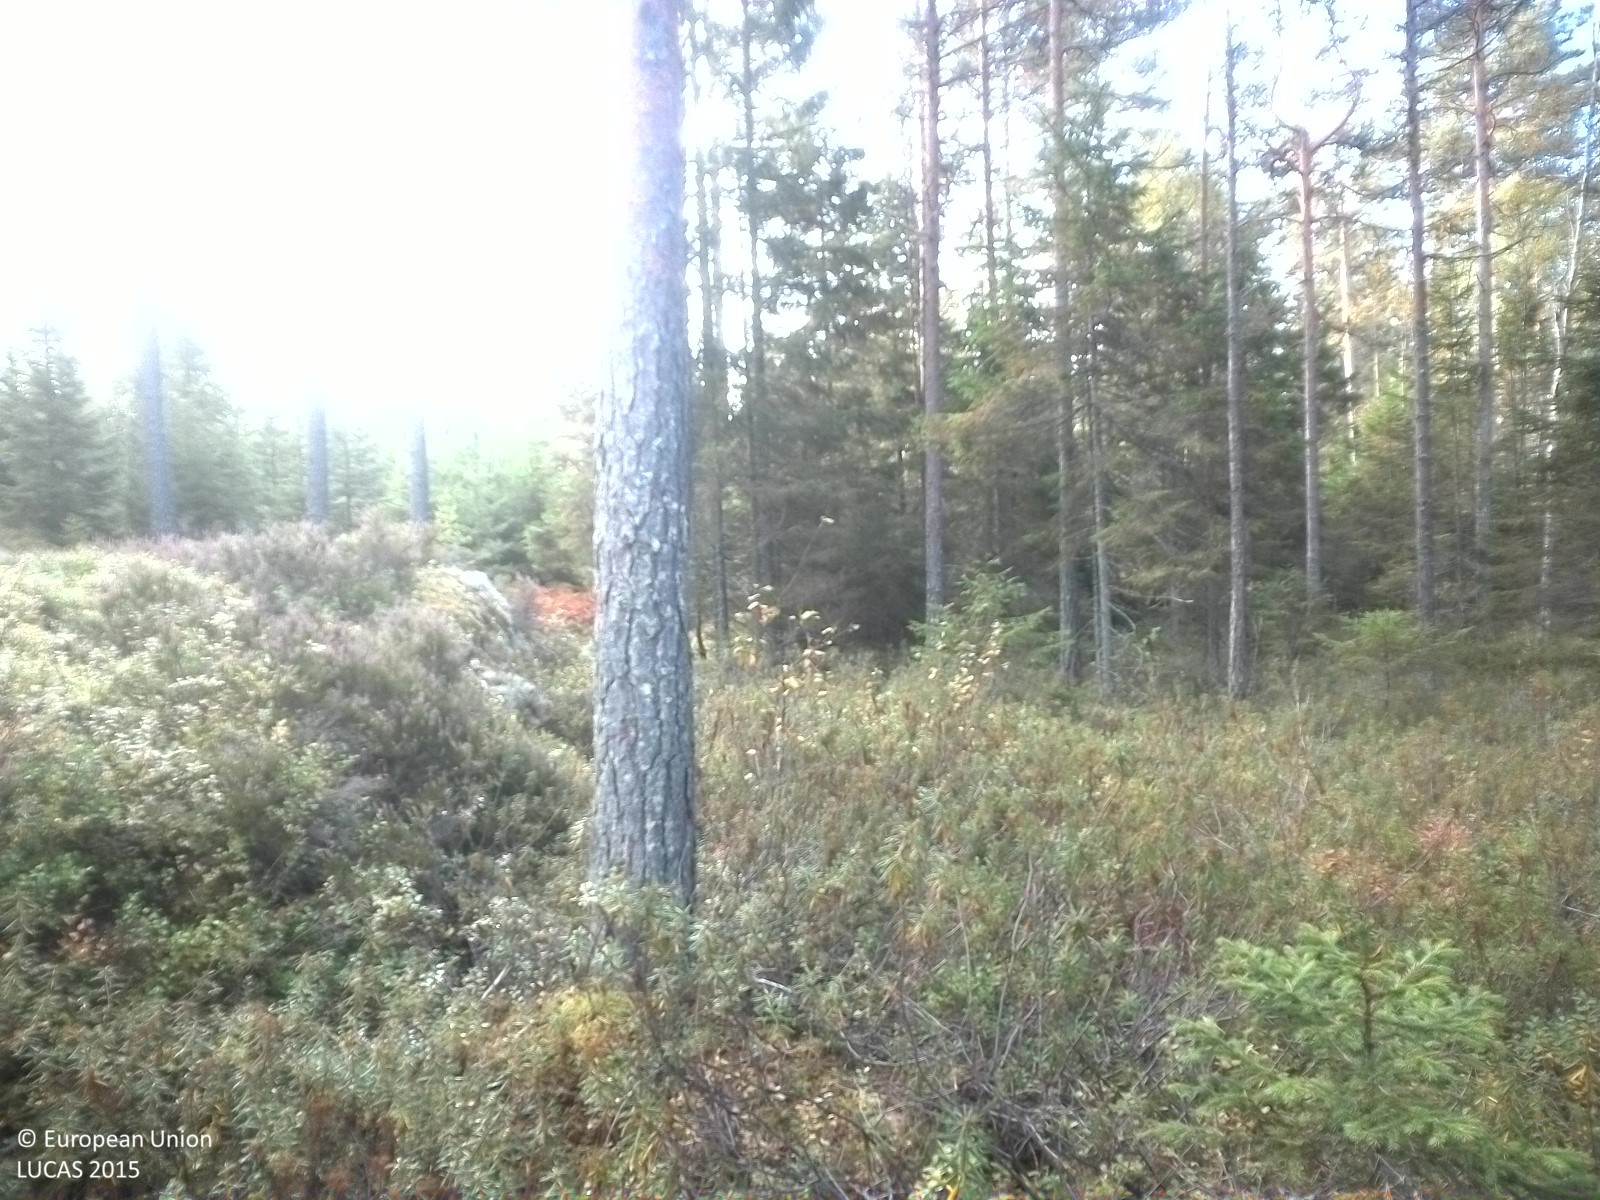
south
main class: Woodland
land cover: Pine dominated coniferous woodland
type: boreal forest
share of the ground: 10 - 25 %
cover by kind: shrubs 50 %, coniferous forest trees 20 %, lichens and mosses 20 %, herbaceous plants 10 %
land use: Forestry
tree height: > 5 m
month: September
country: SE
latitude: 58.9611
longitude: 15.7833
